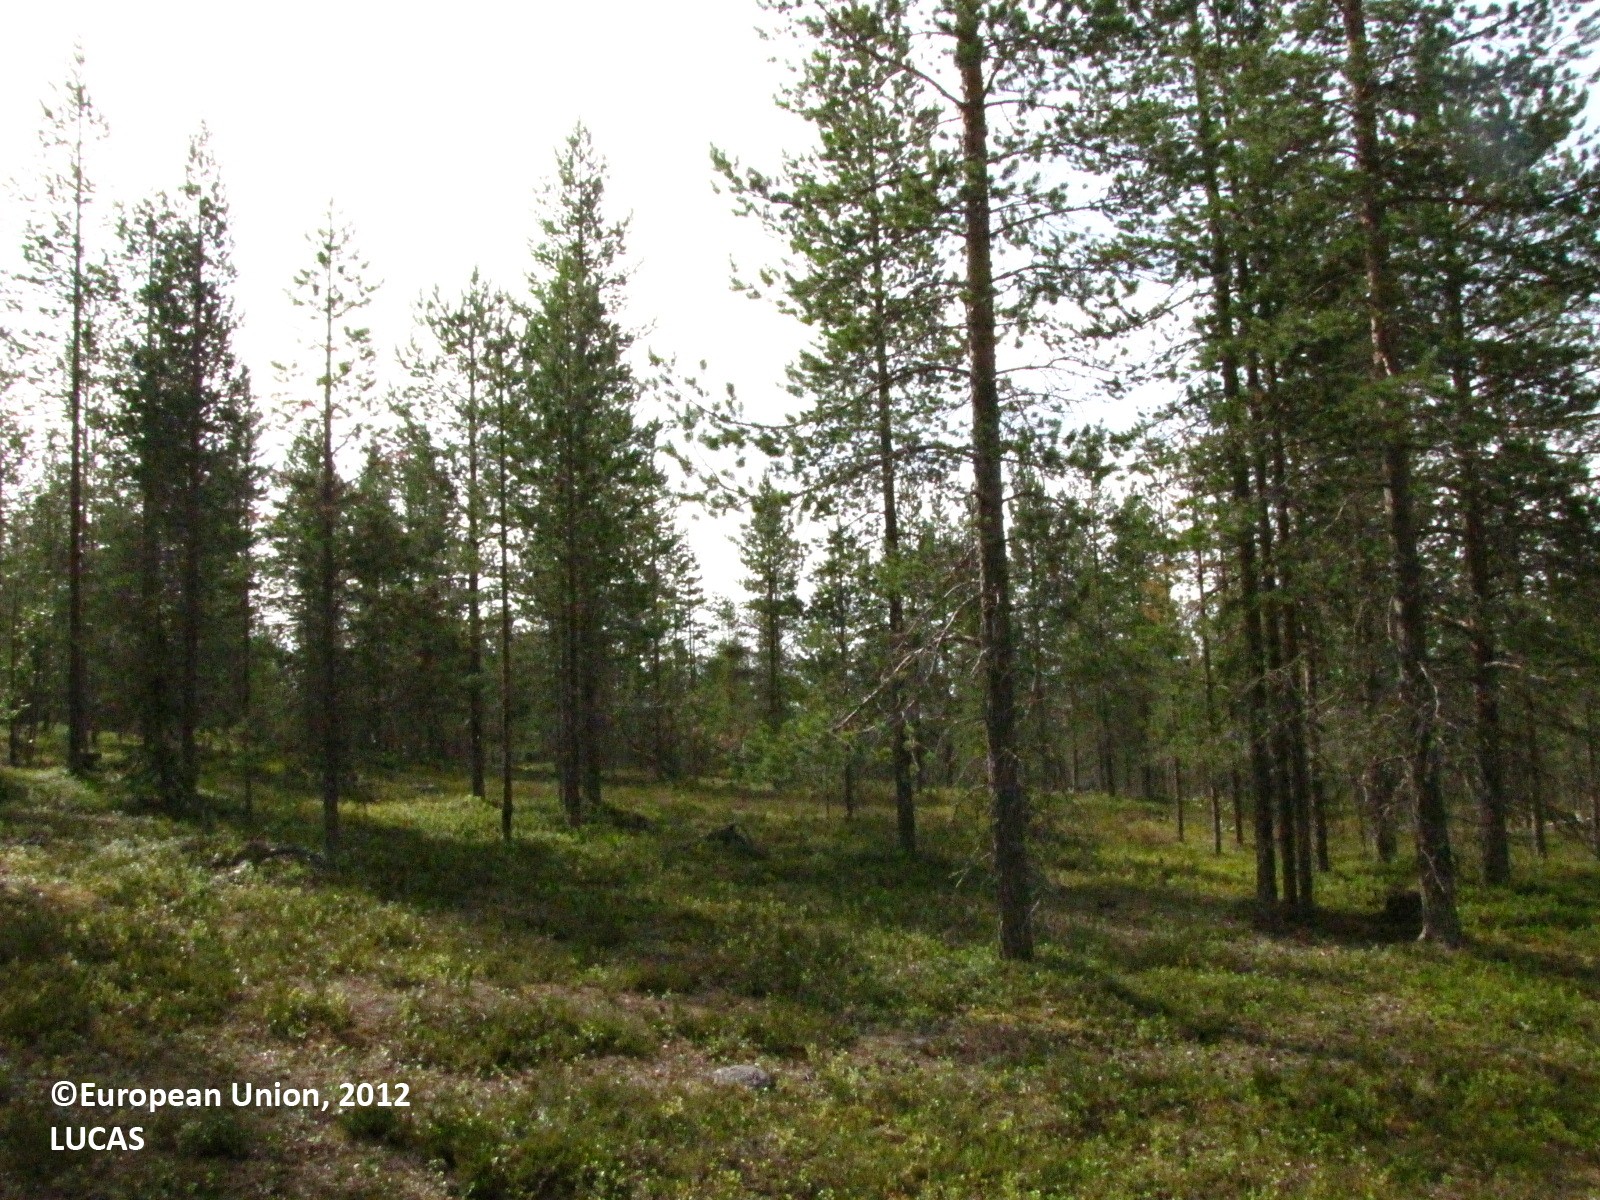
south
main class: Woodland
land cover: Pine dominated coniferous woodland
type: boreal forest
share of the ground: 50 - 75 %
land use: Forestry
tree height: > 5 m
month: July
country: FI
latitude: 66.6439
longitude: 25.1315
